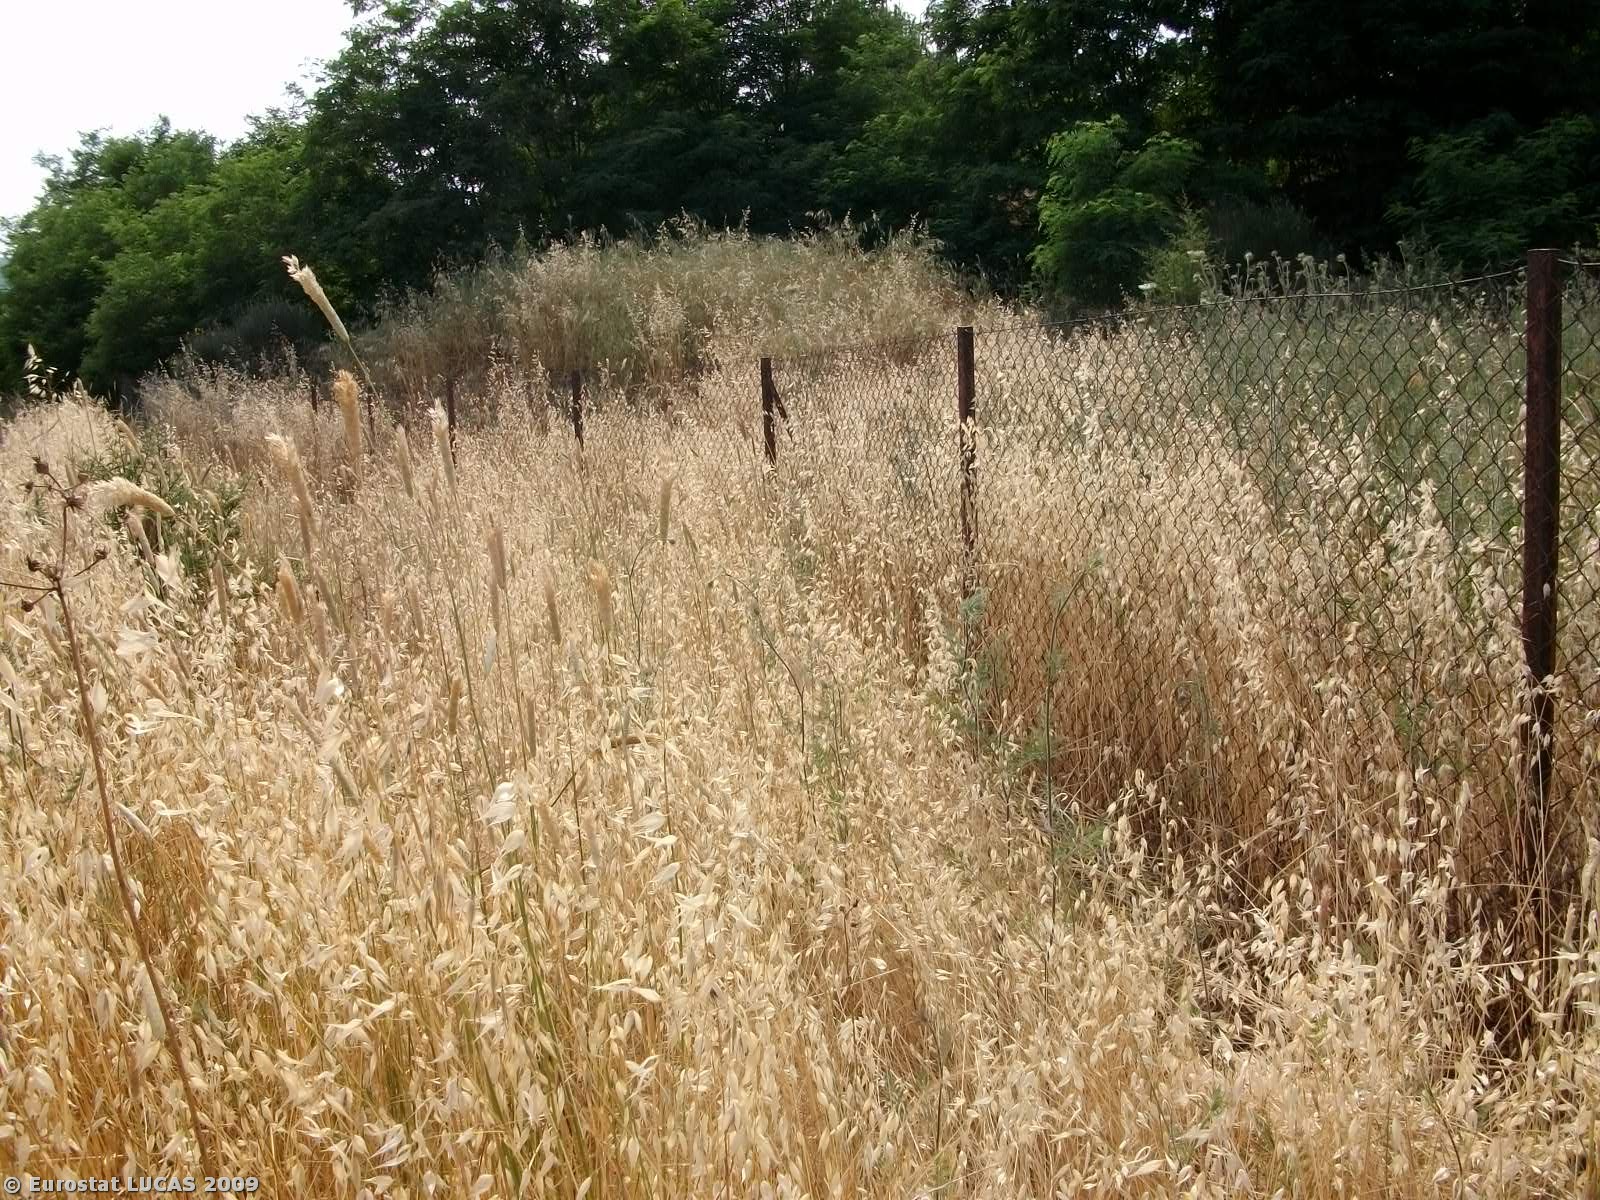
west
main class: Grassland
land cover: Grassland with sparse tree/shrub cover
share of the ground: > 75 %
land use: Unused
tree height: > 5 m
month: June
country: GR
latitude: 37.4346
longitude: 22.0629
